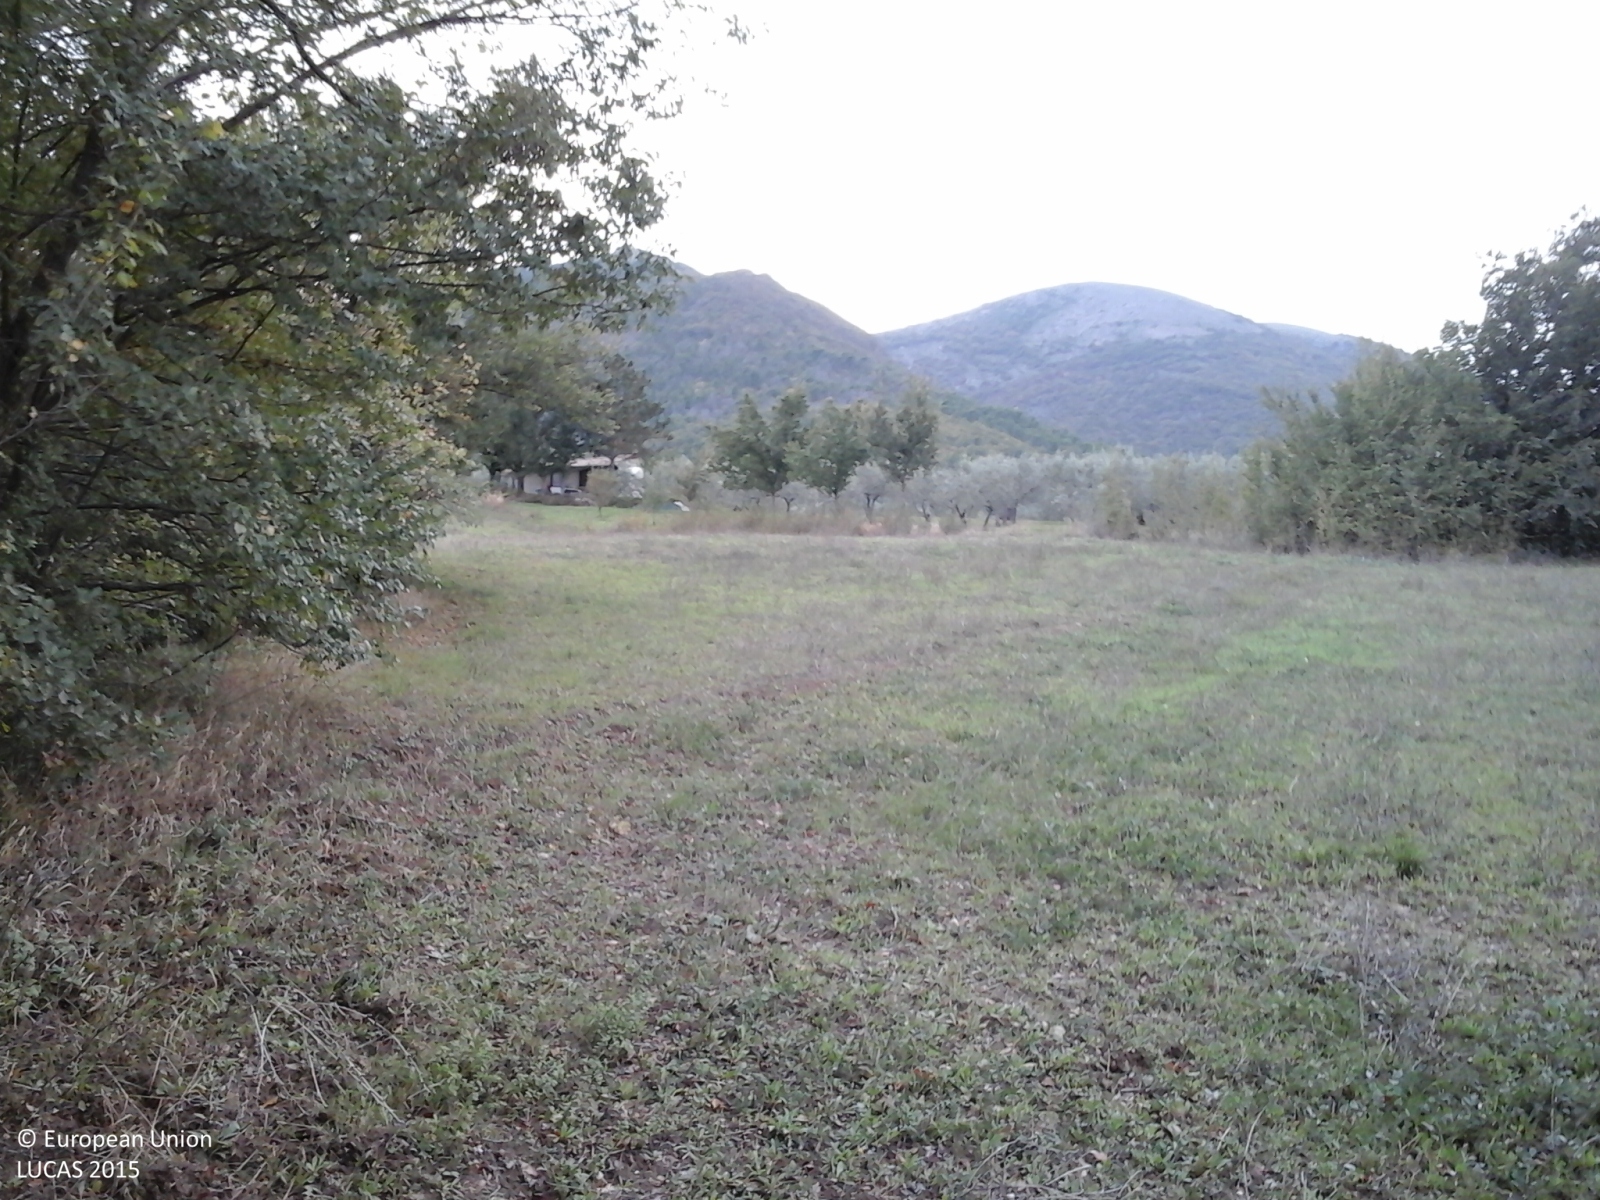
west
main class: Woodland
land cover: Broadleaved woodland
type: thermophilous deciduous forest
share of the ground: 50 - 75 %
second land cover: Grassland without tree/shrub cover
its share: 50 - 75 %
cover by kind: broadleaved forest trees 60 %, herbaceous plants 35 %, shrubs 5 %
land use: Forestry
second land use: Agriculture (excluding fallow land and kitchen gardens)
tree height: > 5 m
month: October
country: IT
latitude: 42.7647
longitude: 12.6192
